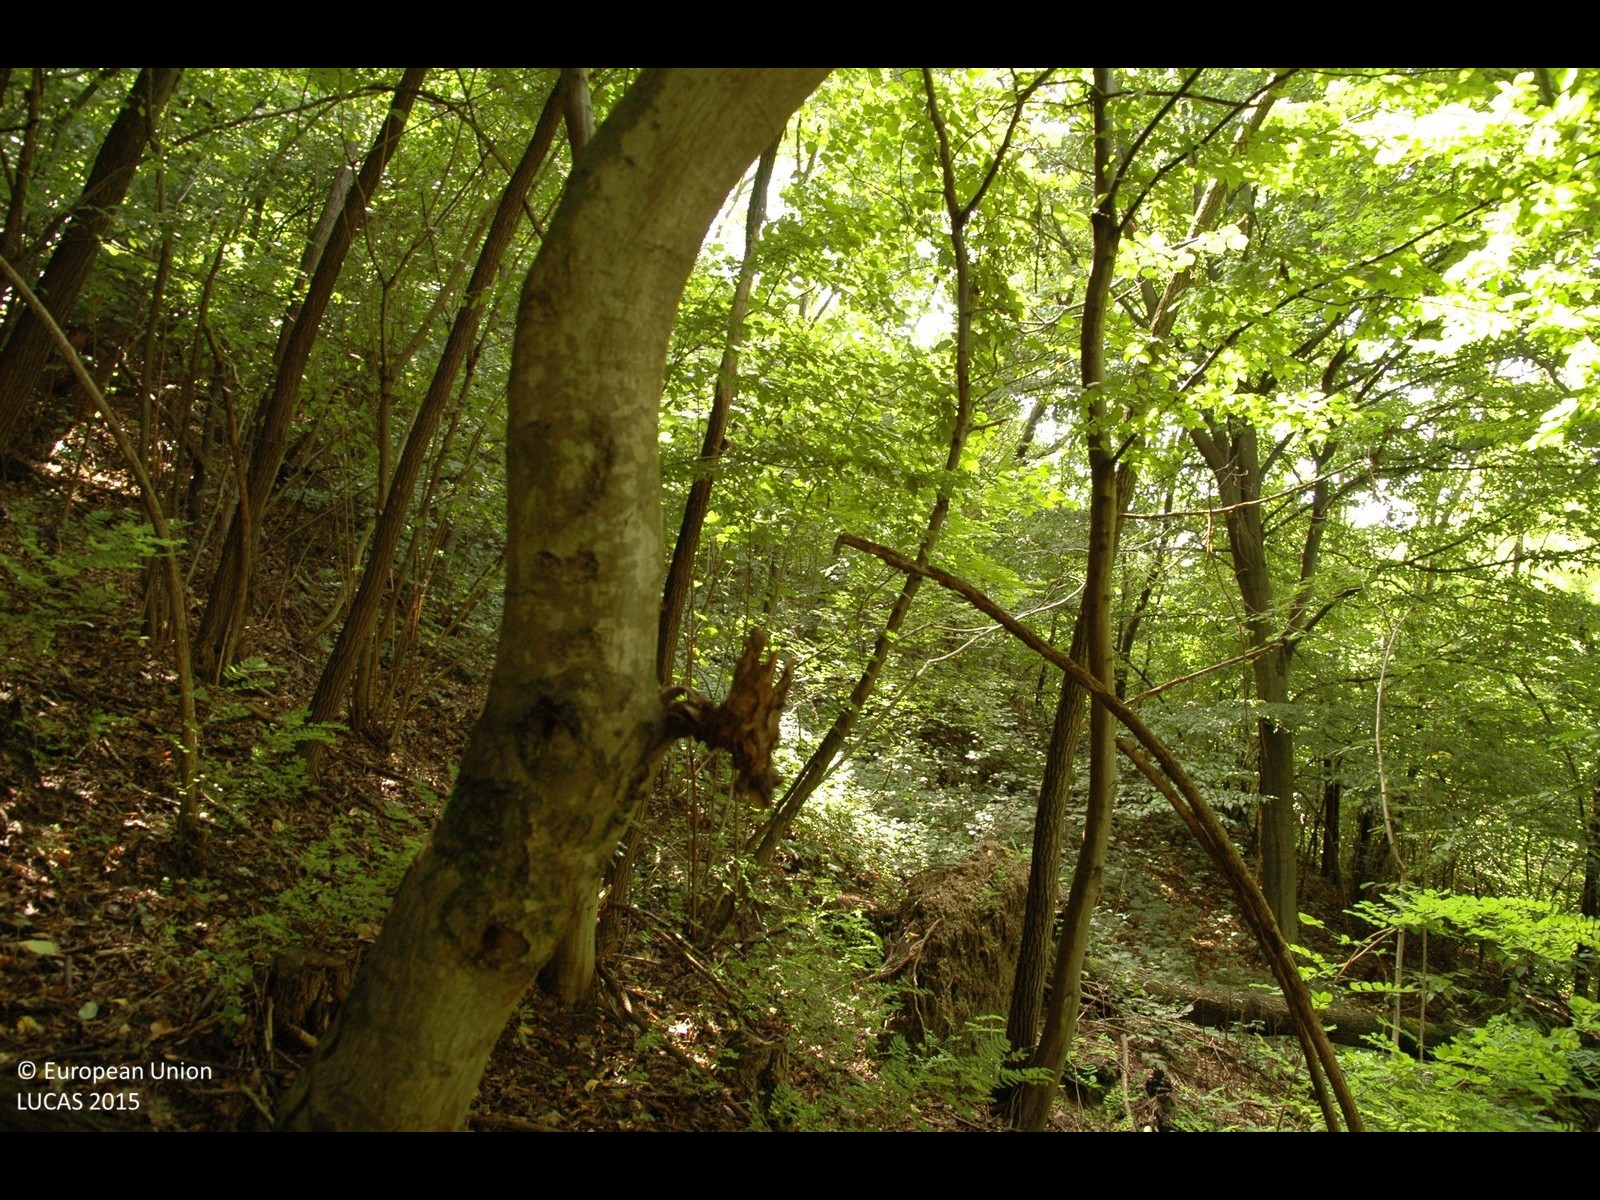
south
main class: Woodland
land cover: Broadleaved woodland
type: mesophytic deciduous forest
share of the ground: > 75 %
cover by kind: broadleaved forest trees 100 %
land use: Forestry
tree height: > 5 m
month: August
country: HR
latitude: 45.9408
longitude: 16.1255
